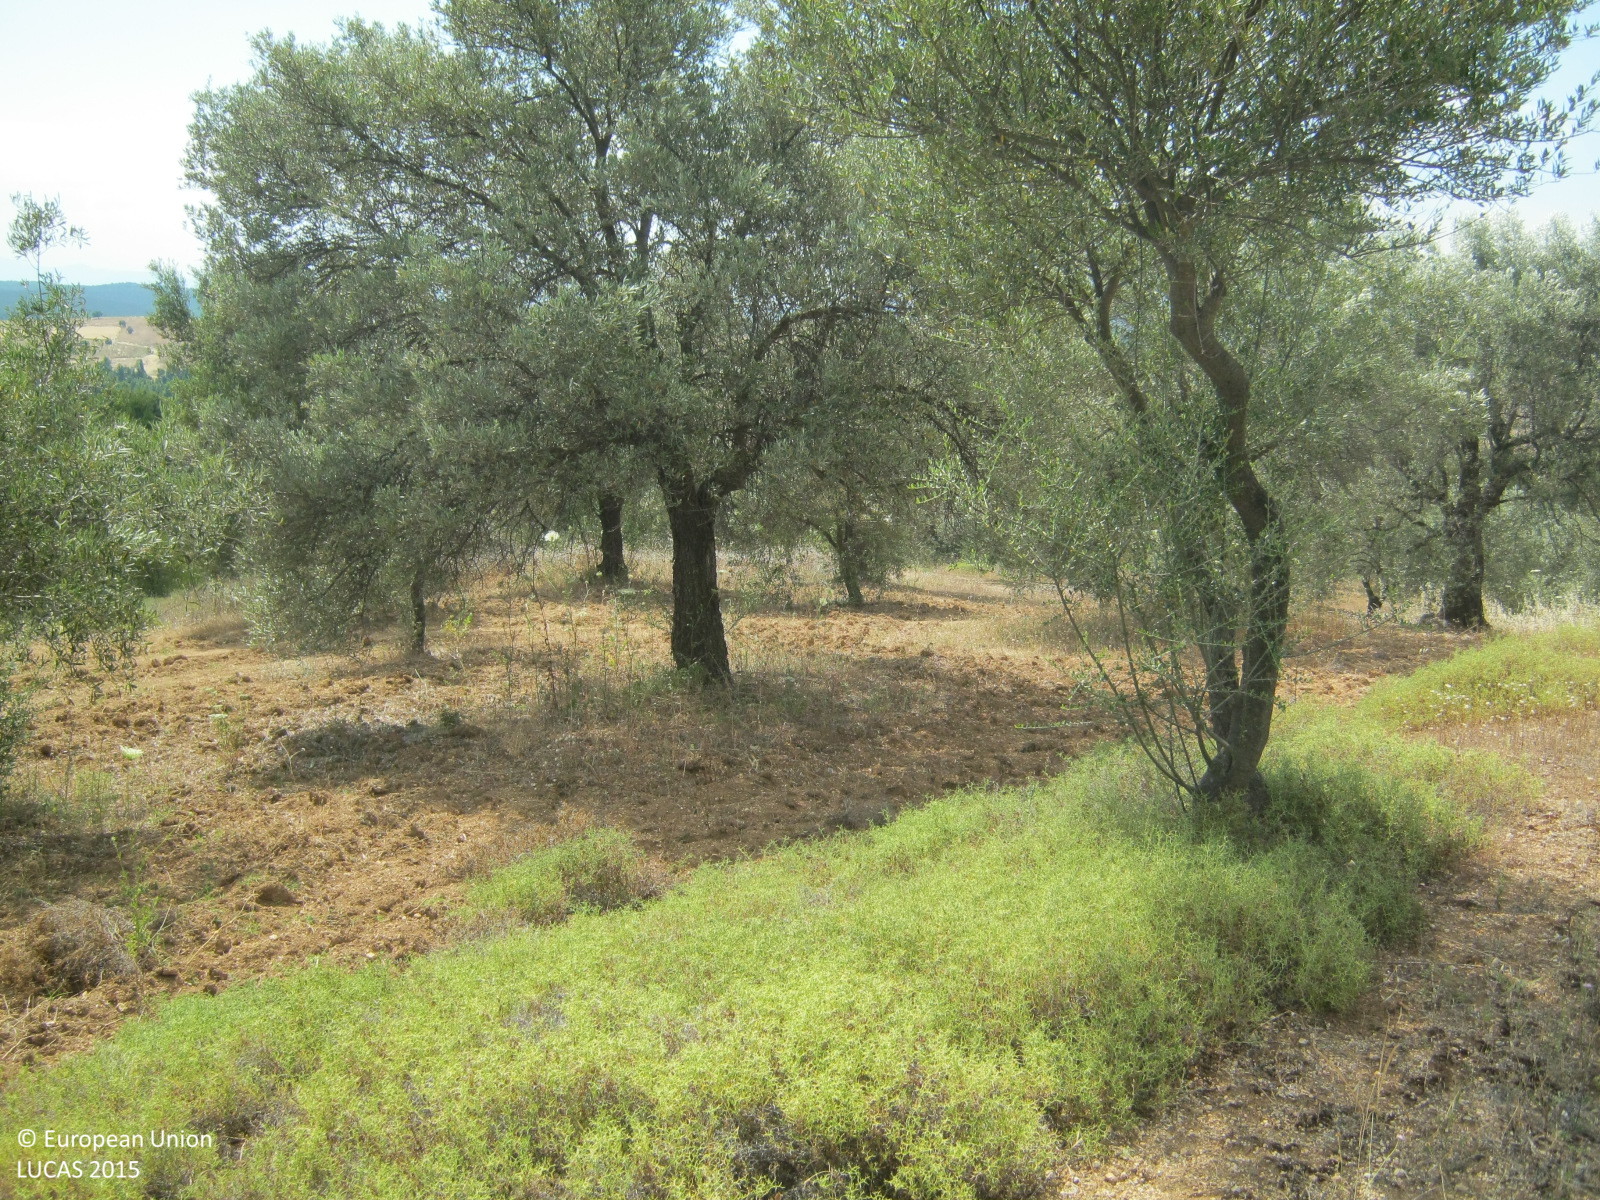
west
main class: Grassland
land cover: Spontaneously vegetated surfaces
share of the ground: > 75 %
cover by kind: herbaceous plants 95 %, shrubs 5 %
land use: Agriculture (excluding fallow land and kitchen gardens)
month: June
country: GR
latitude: 38.5609
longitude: 23.7490
